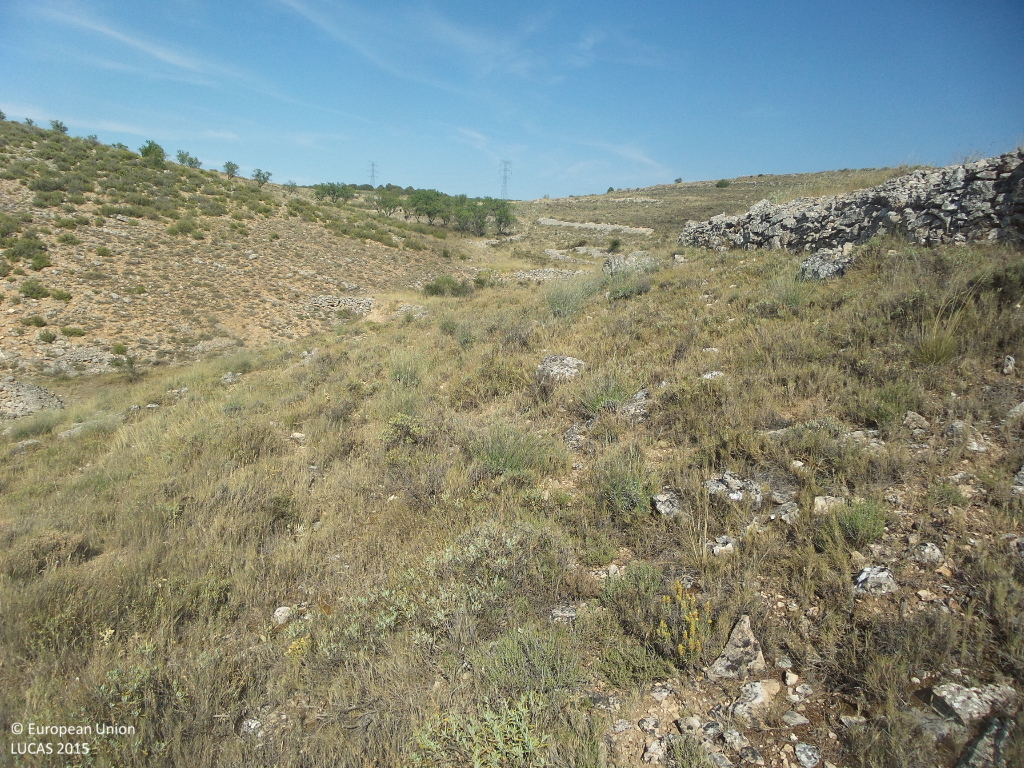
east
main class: Shrubland
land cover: Shrubland without tree cover
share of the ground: 50 - 75 %
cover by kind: shrubs 70 %, unconsolidated bare surface 25 %, herbaceous plants 5 %
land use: Semi-natural and natural areas not in use
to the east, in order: Shrubland without tree cover; Dry stone walls; Shrubland without tree cover
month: July
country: ES
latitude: 41.2621
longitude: -1.8548
